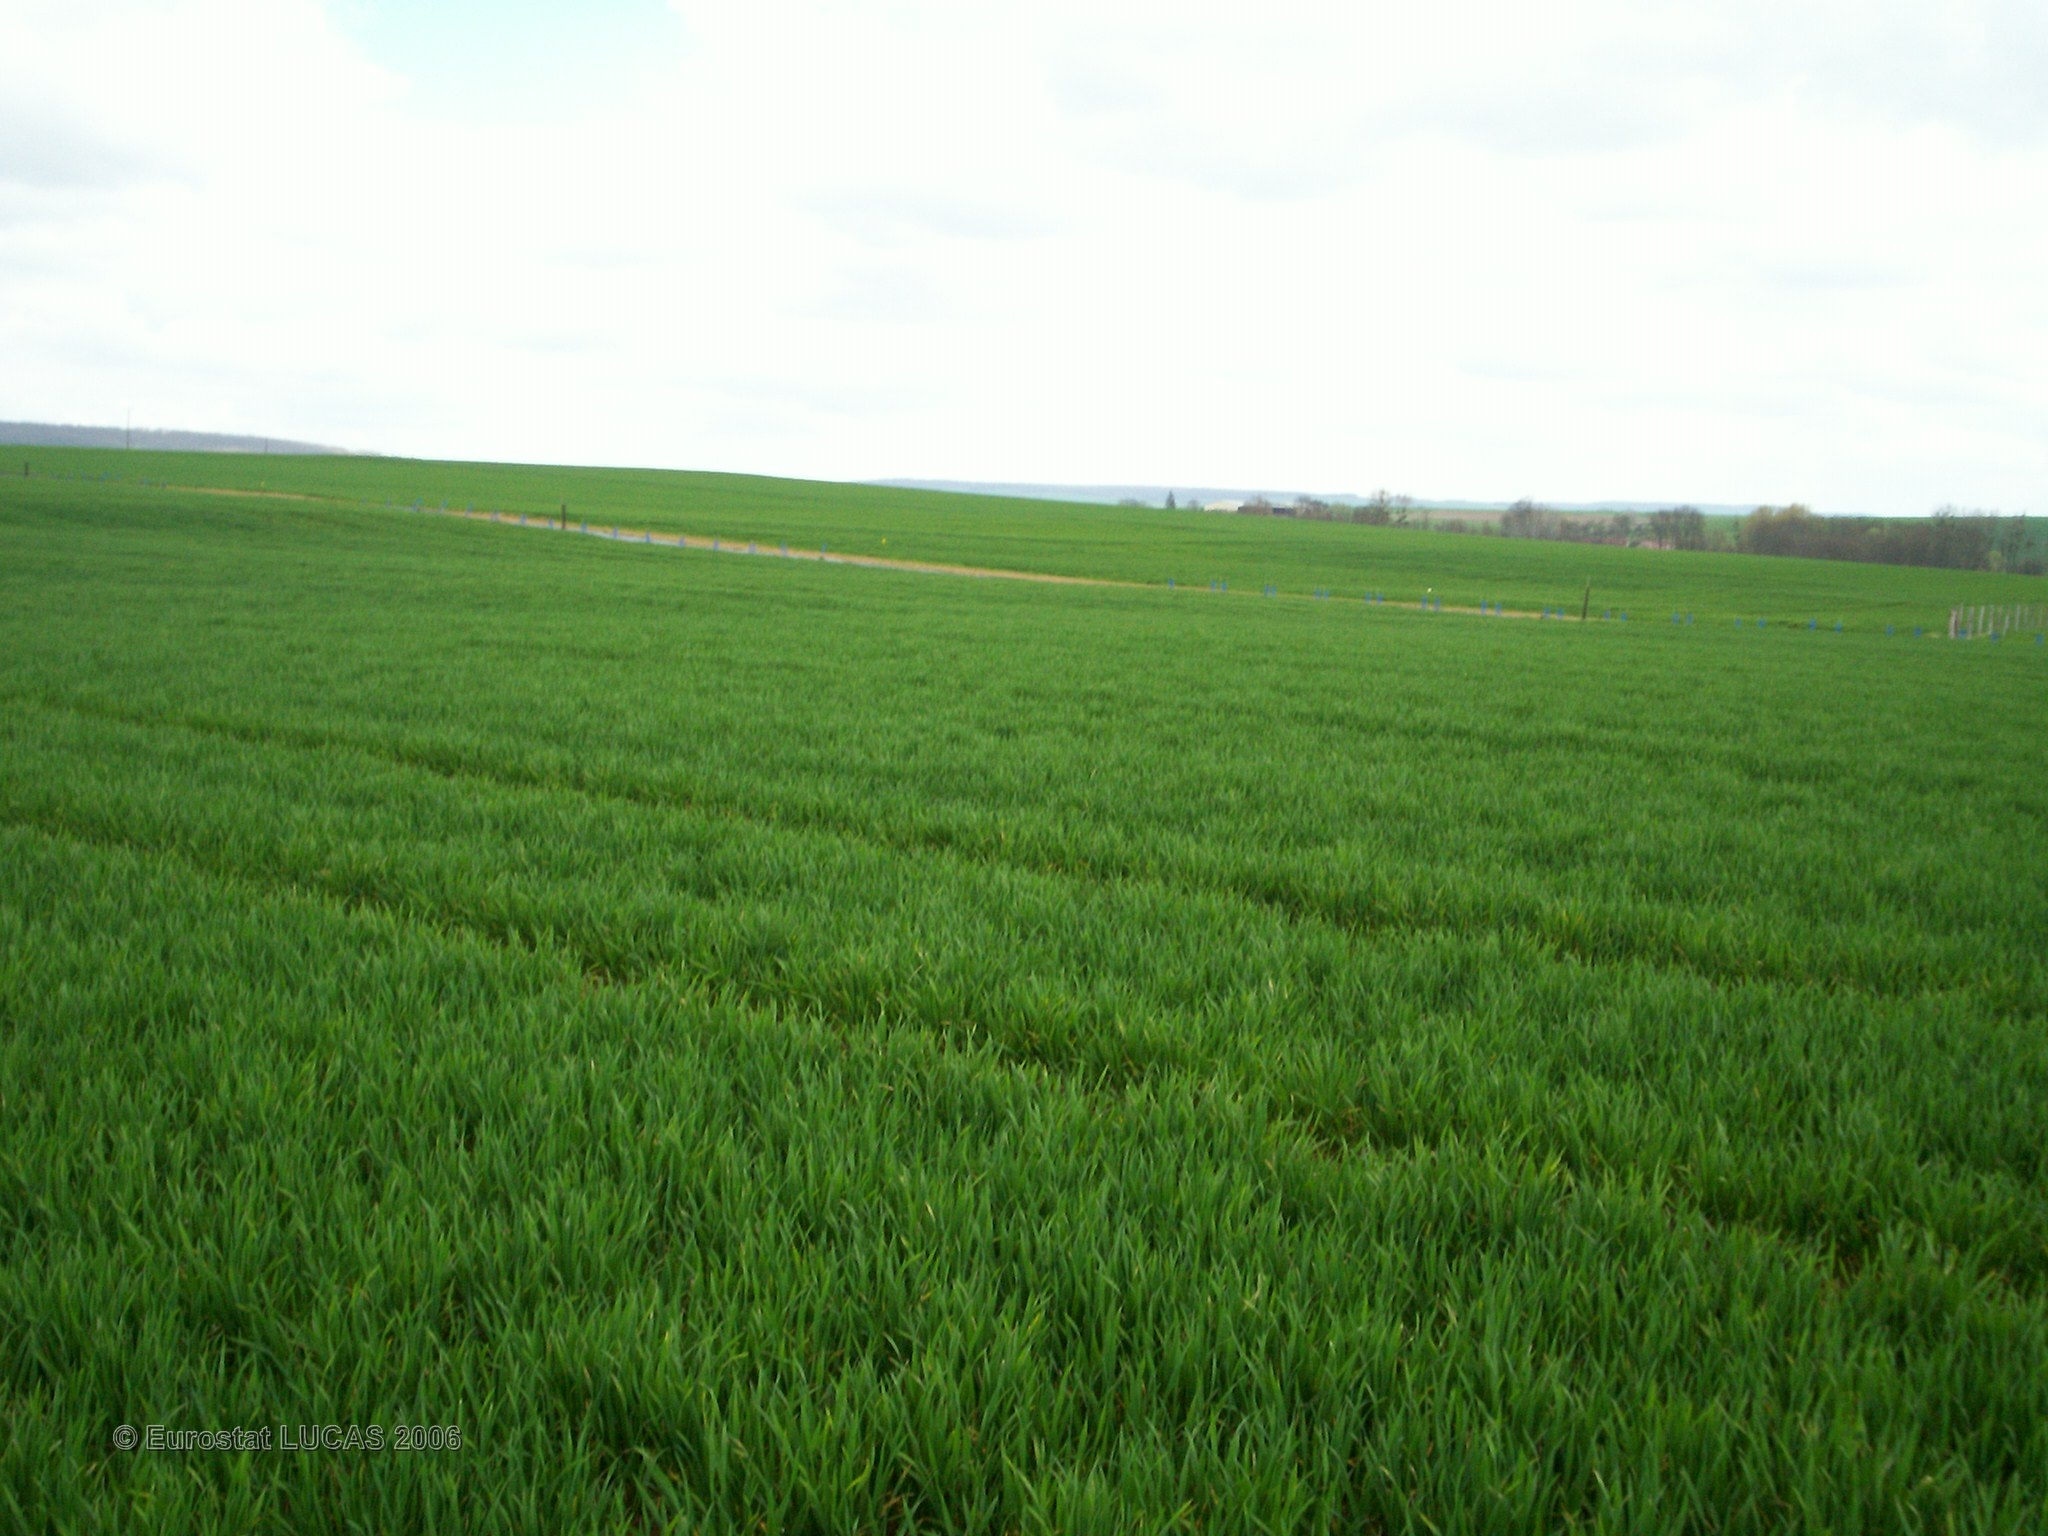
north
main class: Cropland
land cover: Common wheat
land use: Agriculture (excluding fallow land and kitchen gardens)
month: April
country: FR
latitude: 48.0497
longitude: 3.8115
